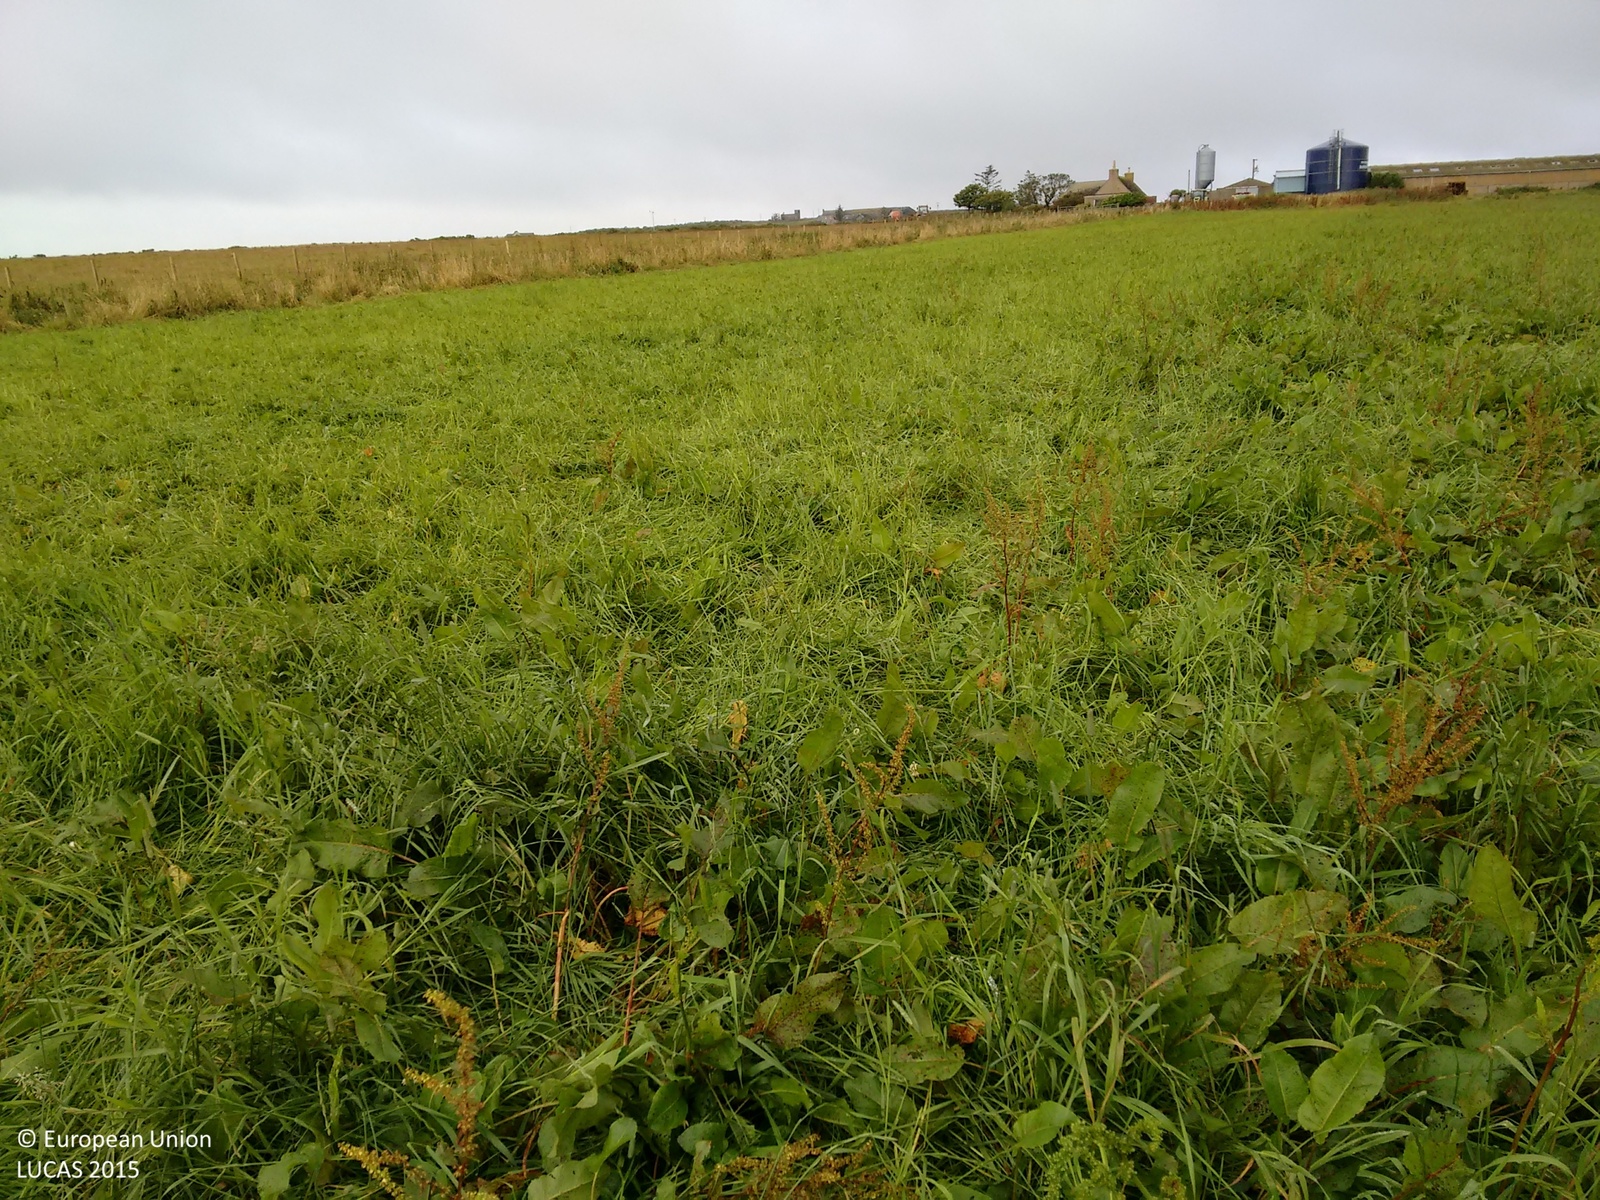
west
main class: Grassland
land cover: Grassland without tree/shrub cover
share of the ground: > 75 %
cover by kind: herbaceous plants 100 %
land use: Agriculture (excluding fallow land and kitchen gardens)
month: August
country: GB
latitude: 58.4659
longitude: -3.1380
